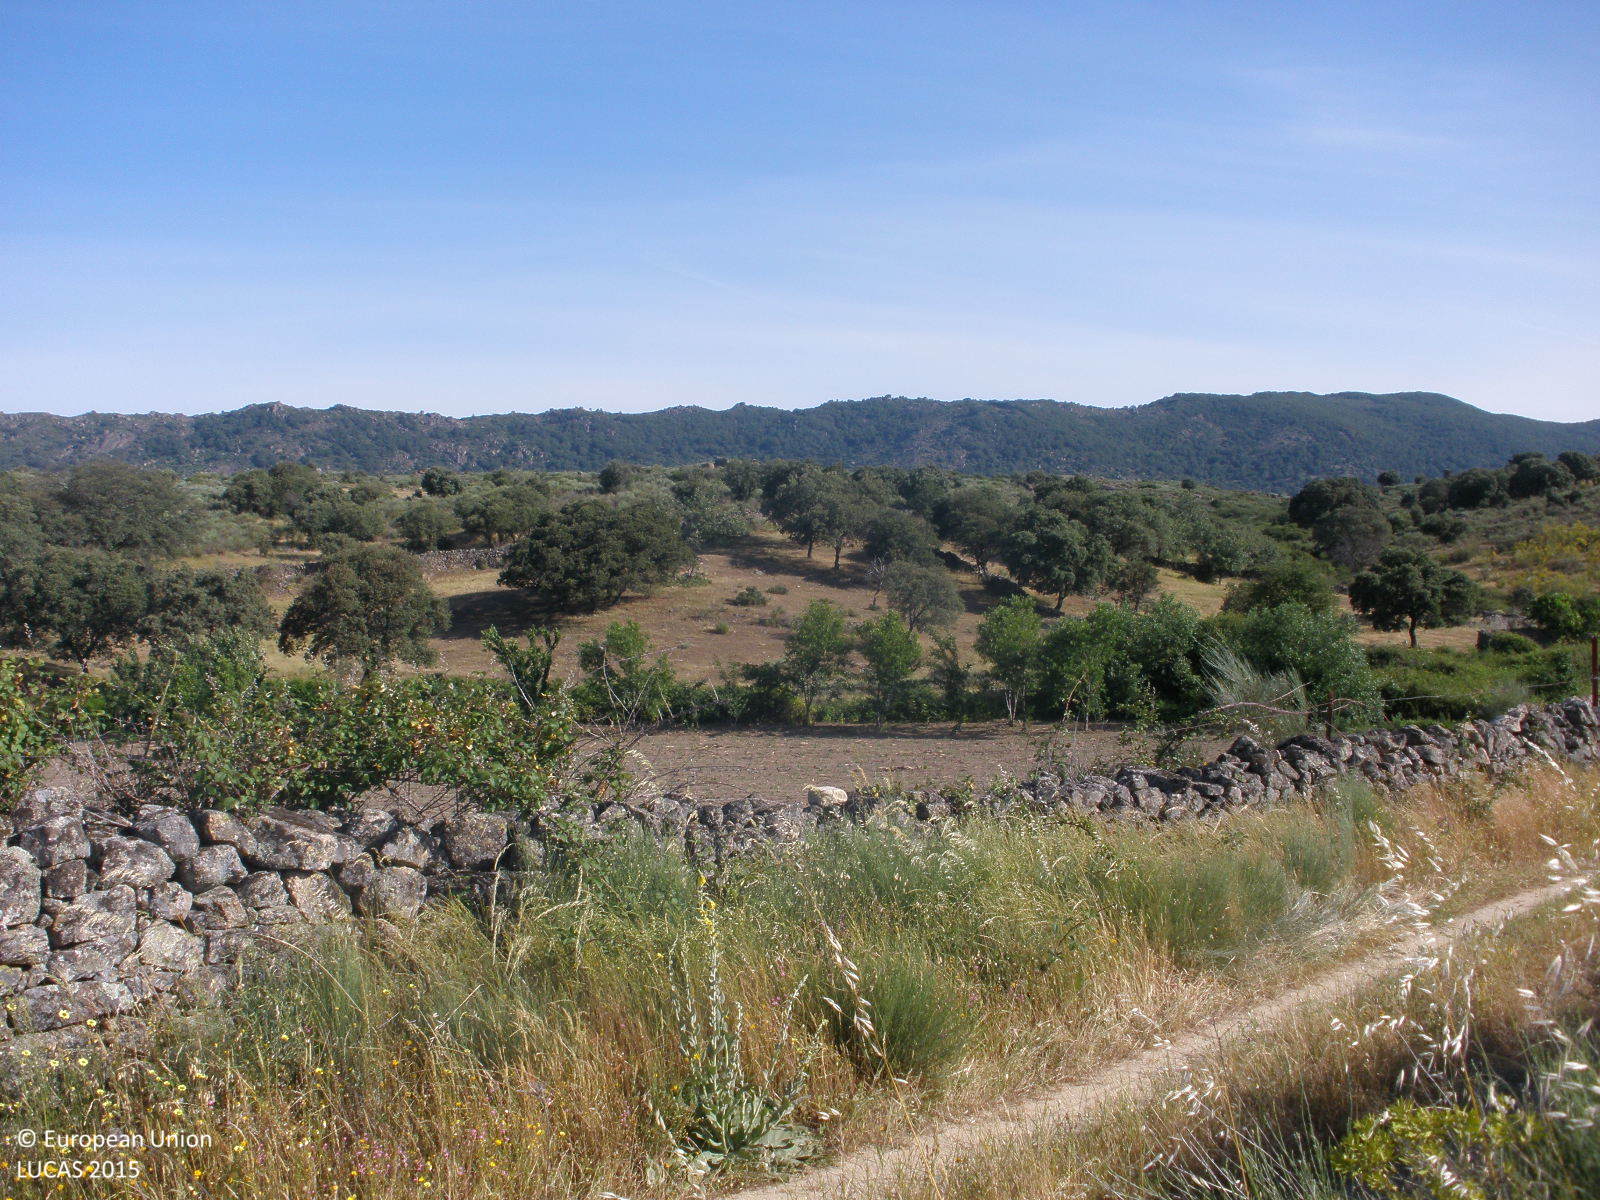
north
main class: Grassland
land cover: Grassland without tree/shrub cover
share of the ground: > 75 %
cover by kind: herbaceous plants 100 %
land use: Agriculture (excluding fallow land and kitchen gardens)
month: May
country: ES
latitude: 40.1046
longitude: -6.7568
